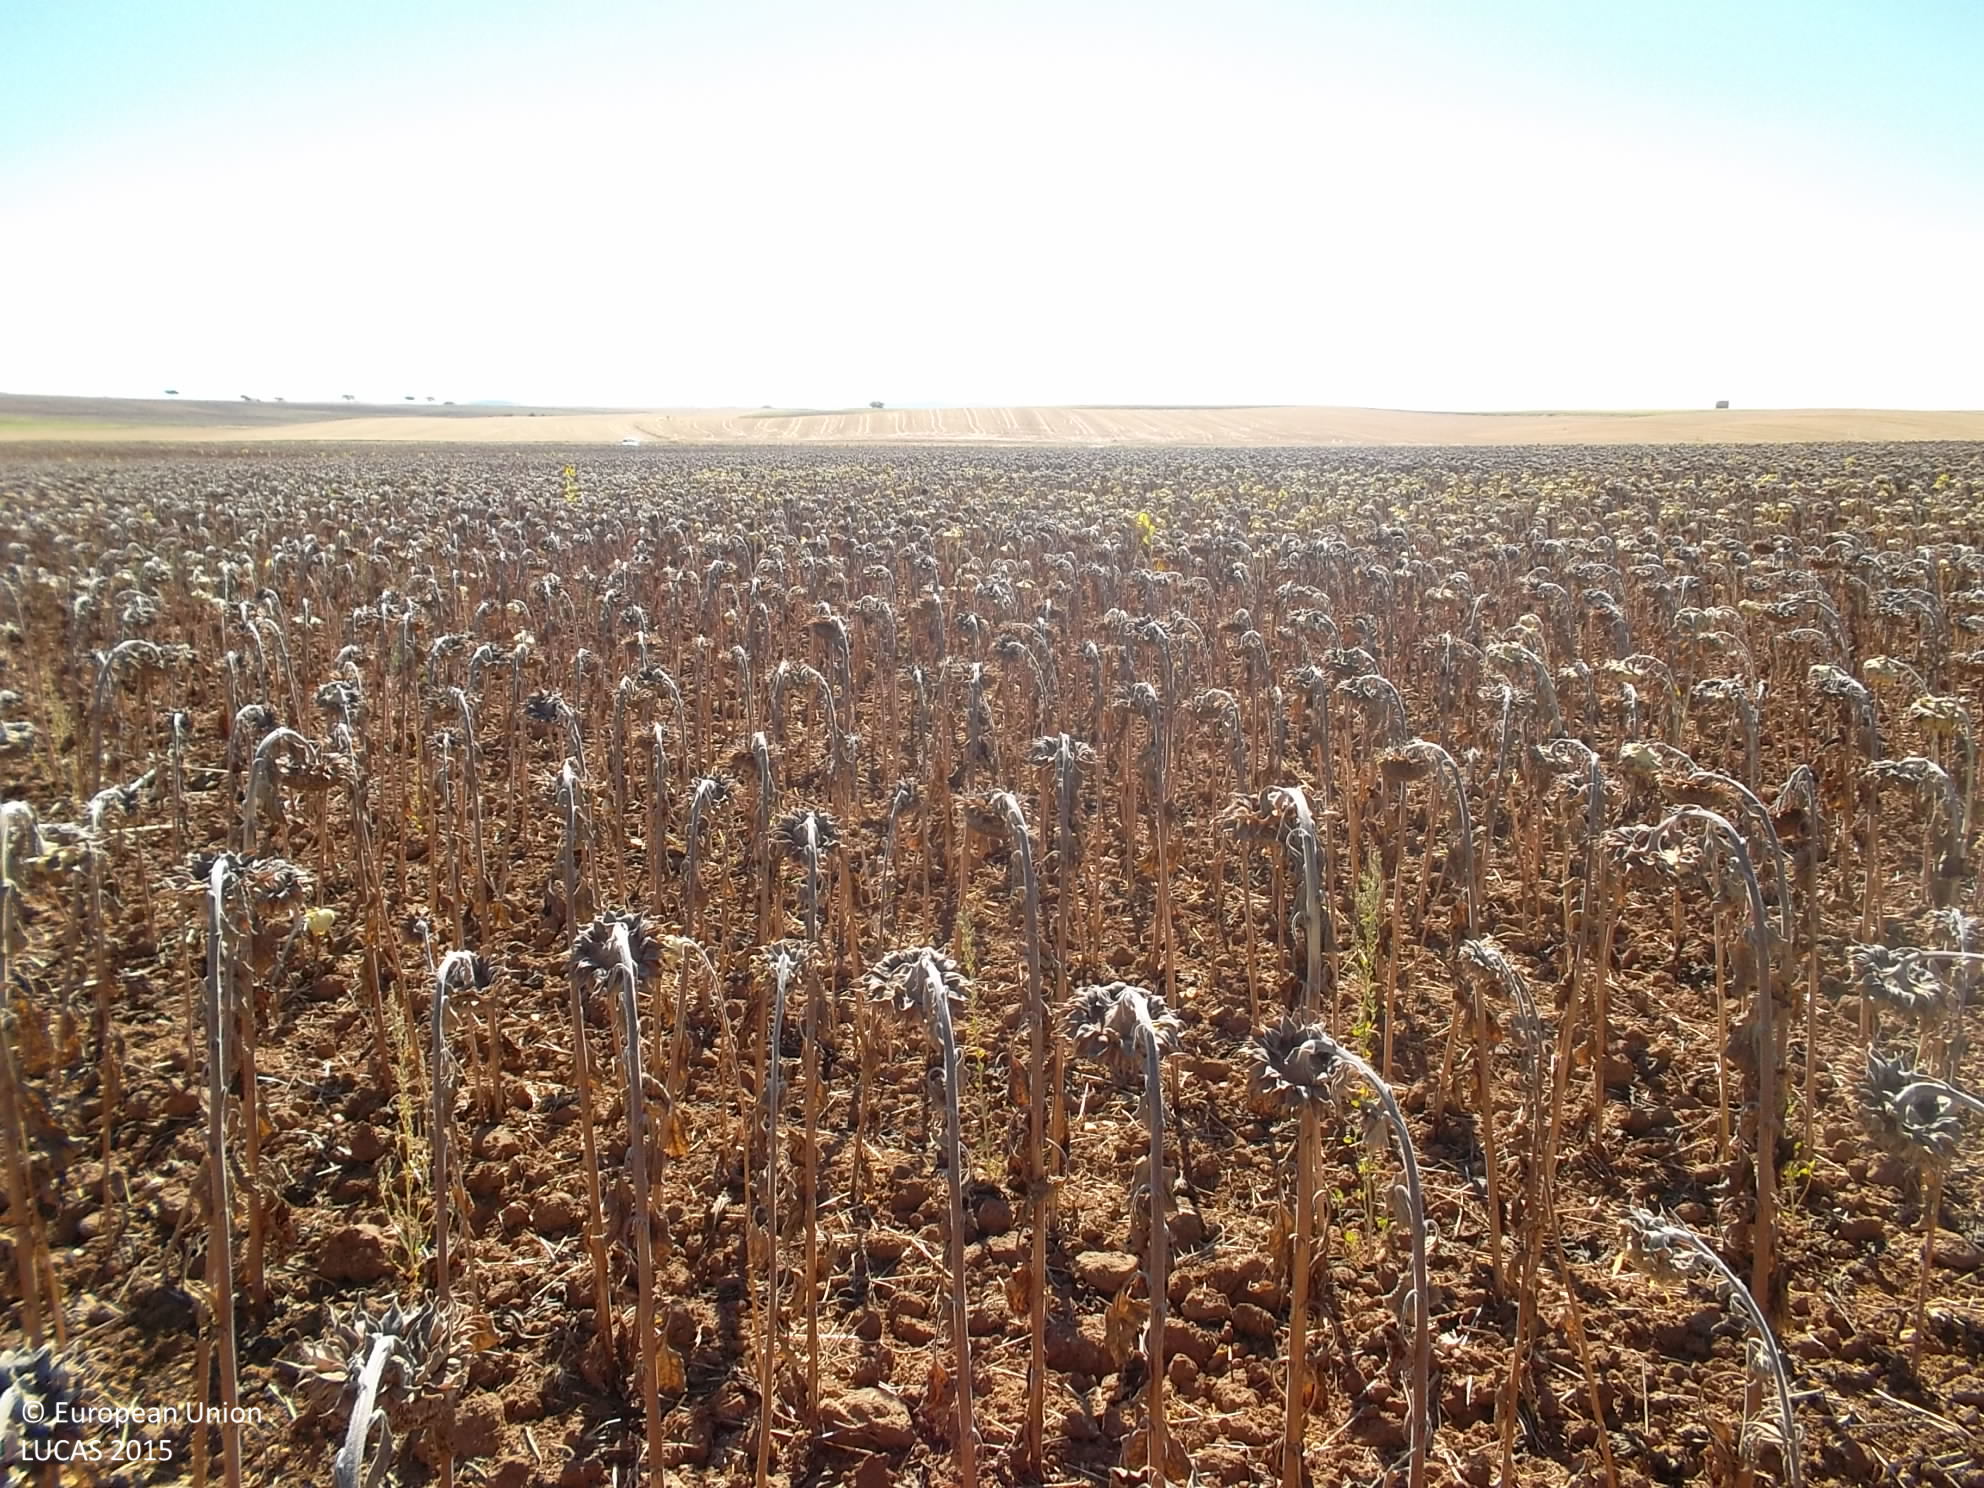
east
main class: Cropland
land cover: Sunflower
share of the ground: > 75 %
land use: Agriculture (excluding fallow land and kitchen gardens)
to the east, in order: Sunflower; Grass margins; Barley
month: July
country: ES
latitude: 38.4033
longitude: -5.7138
